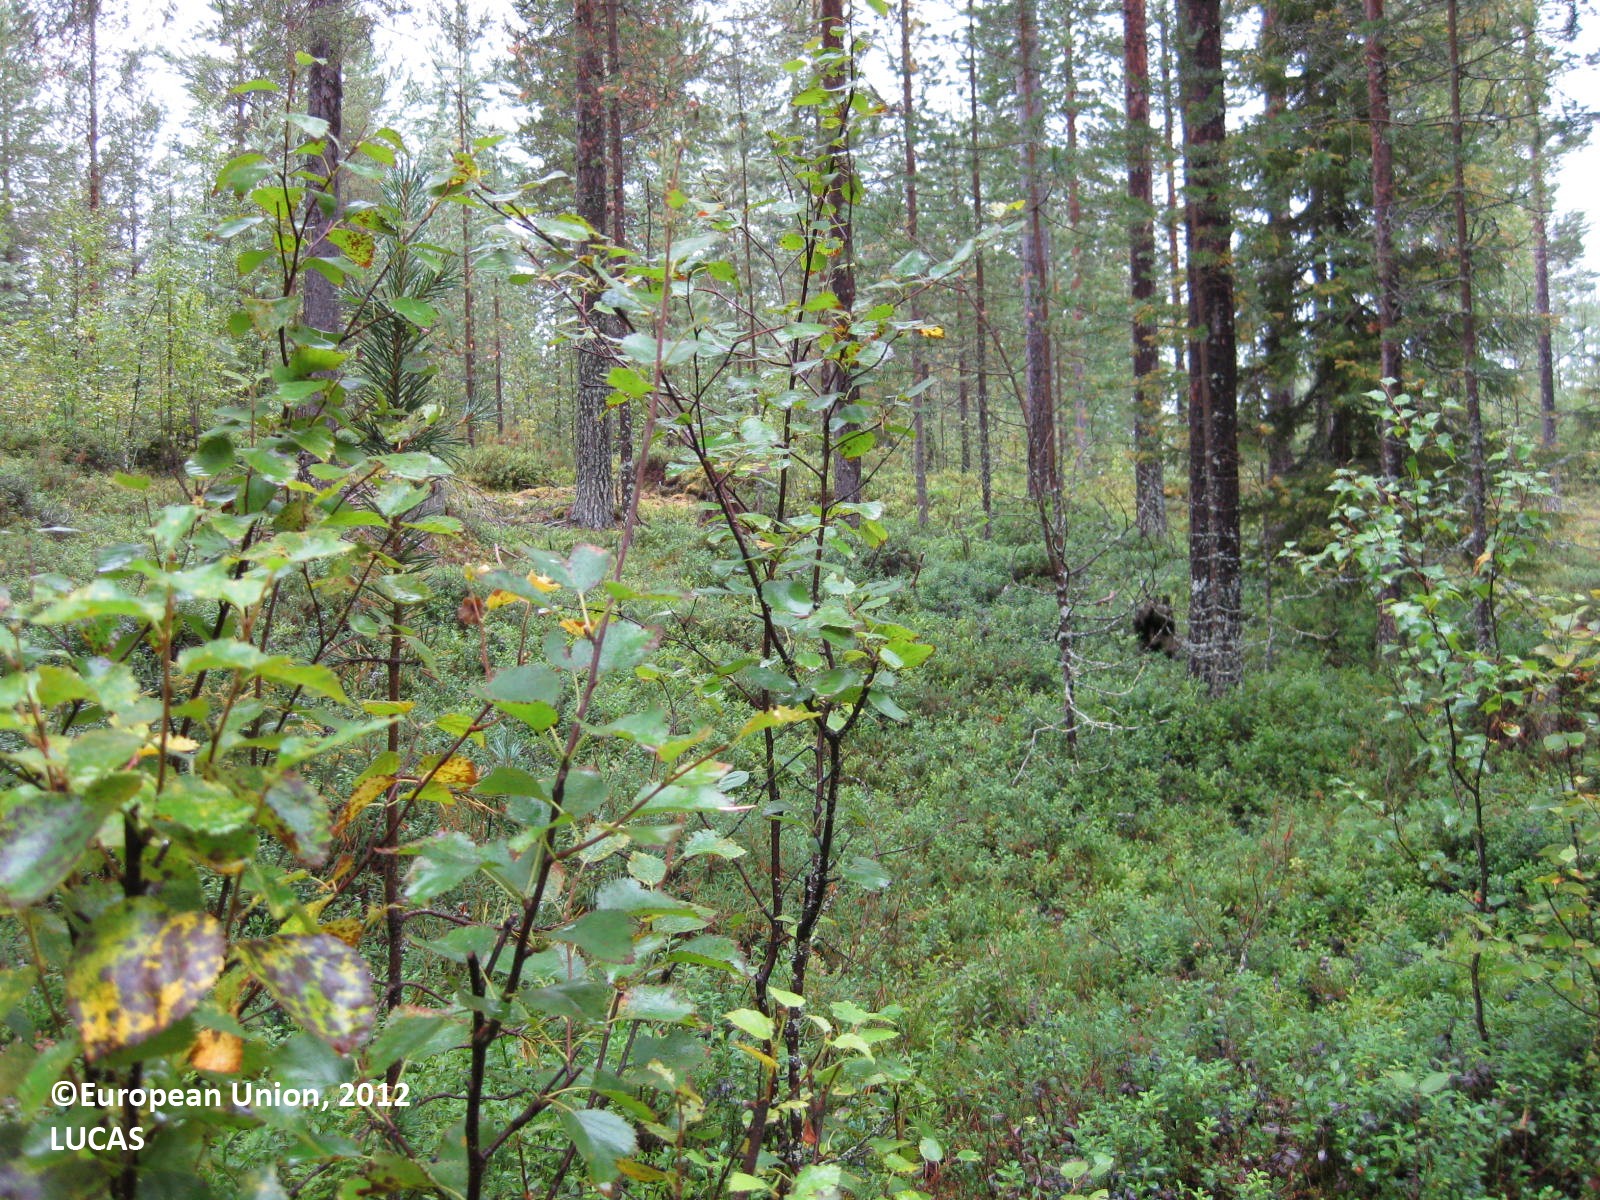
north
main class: Woodland
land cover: Pine dominated mixed woodland
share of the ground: > 75 %
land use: Forestry
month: August
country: FI
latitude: 66.1408
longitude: 28.7946
